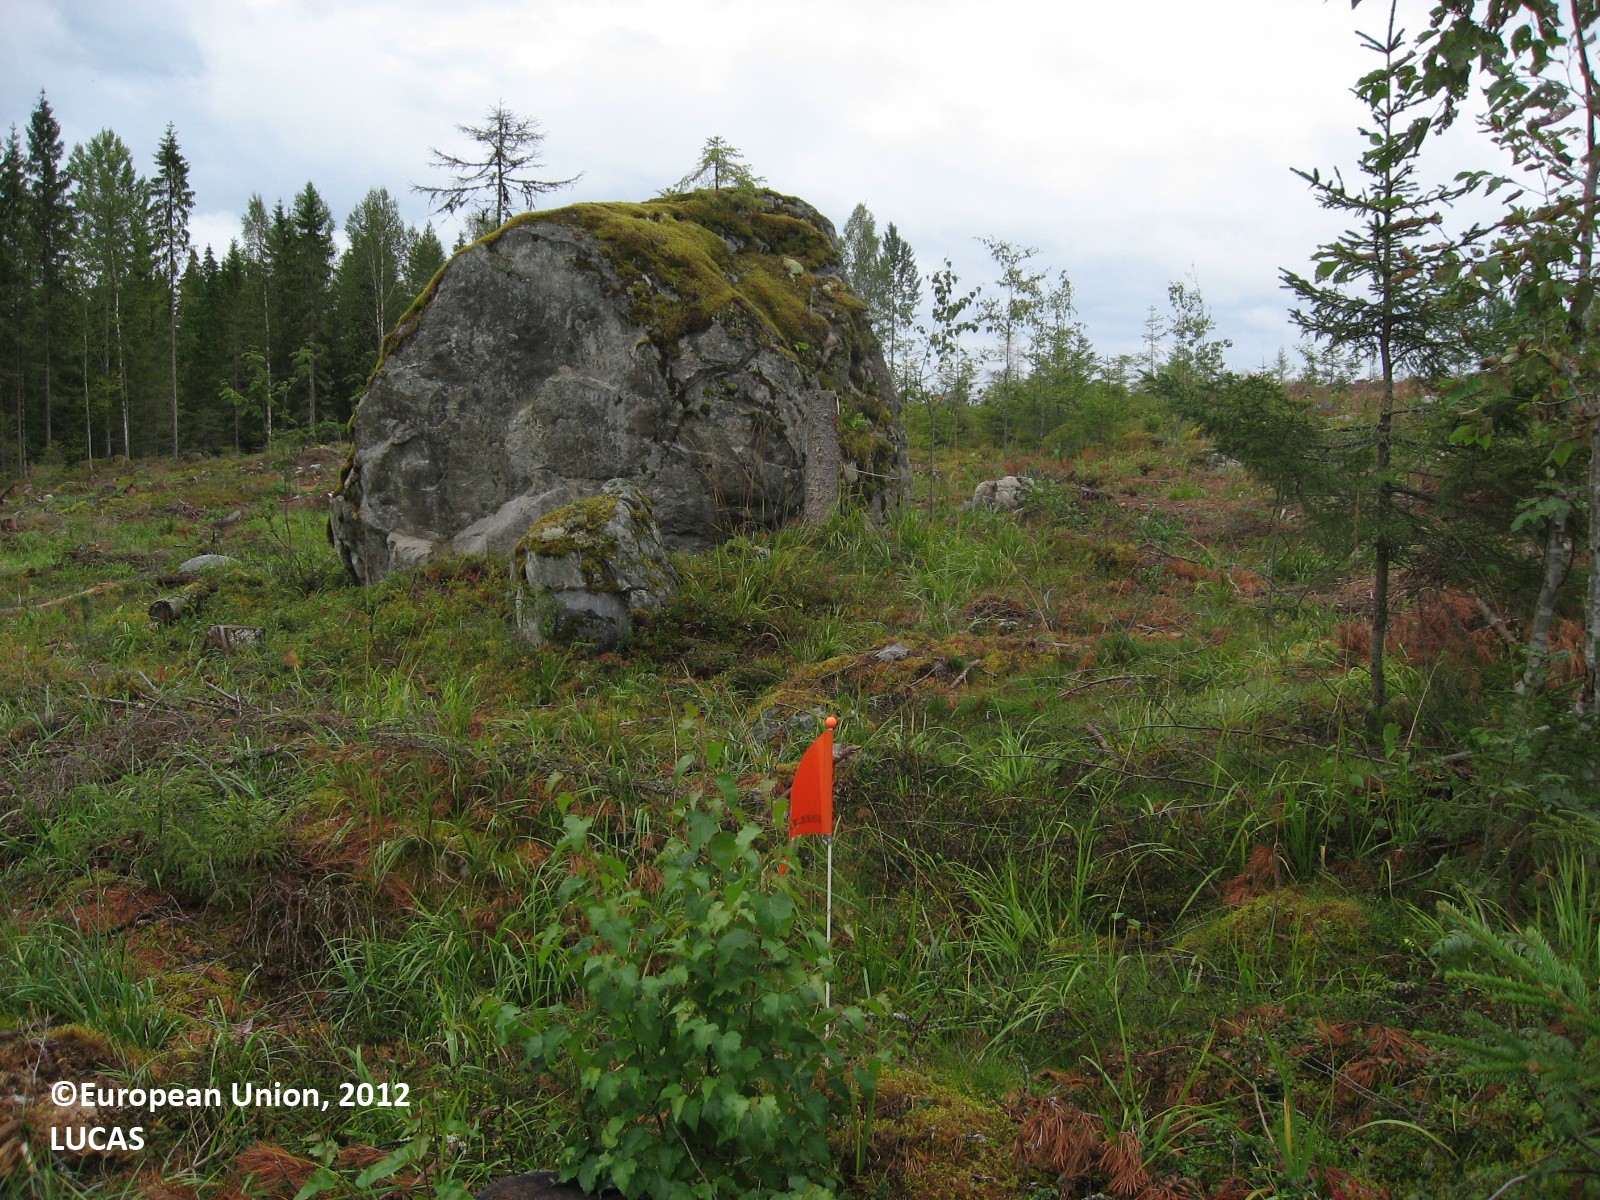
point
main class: Grassland
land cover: Grassland with sparse tree/shrub cover
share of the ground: 50 - 75 %
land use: Forestry
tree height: < 5 m
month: August
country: FI
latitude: 61.4564
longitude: 24.7563
